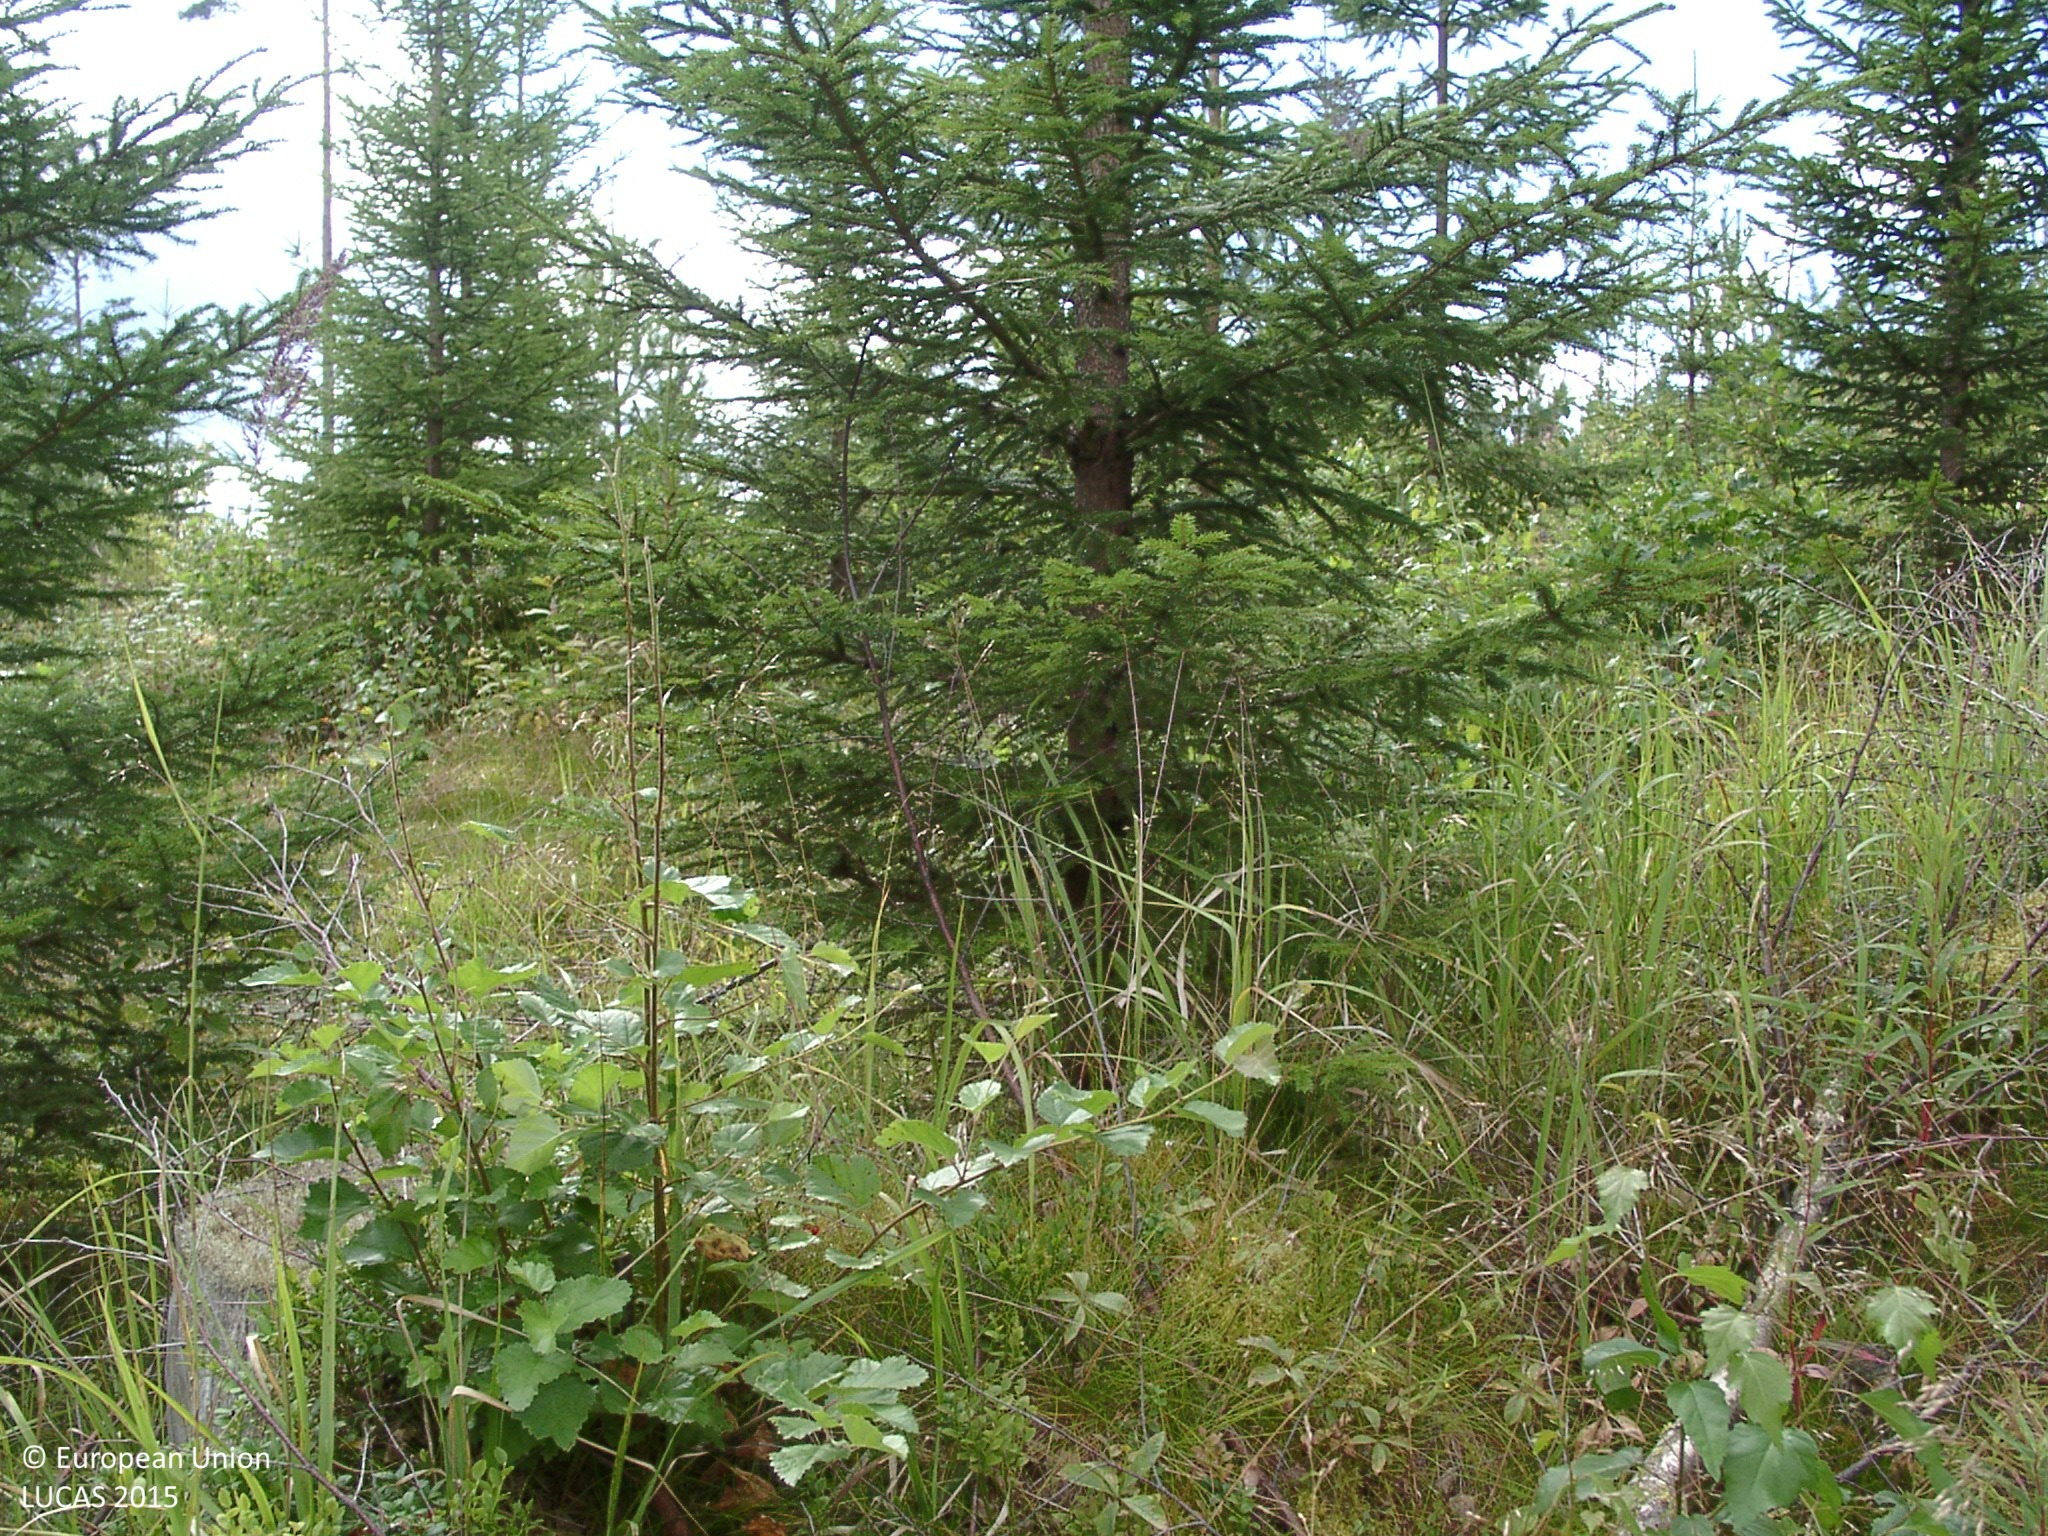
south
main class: Woodland
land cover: Other coniferous woodland
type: boreal forest
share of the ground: 50 - 75 %
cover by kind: coniferous forest trees 50 %, broadleaved forest trees 15 %, shrubs 10 %, herbaceous plants 10 %, lichens and mosses 5 %
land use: Forestry
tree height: < 5 m
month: August
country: FI
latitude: 62.3467
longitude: 25.5855
